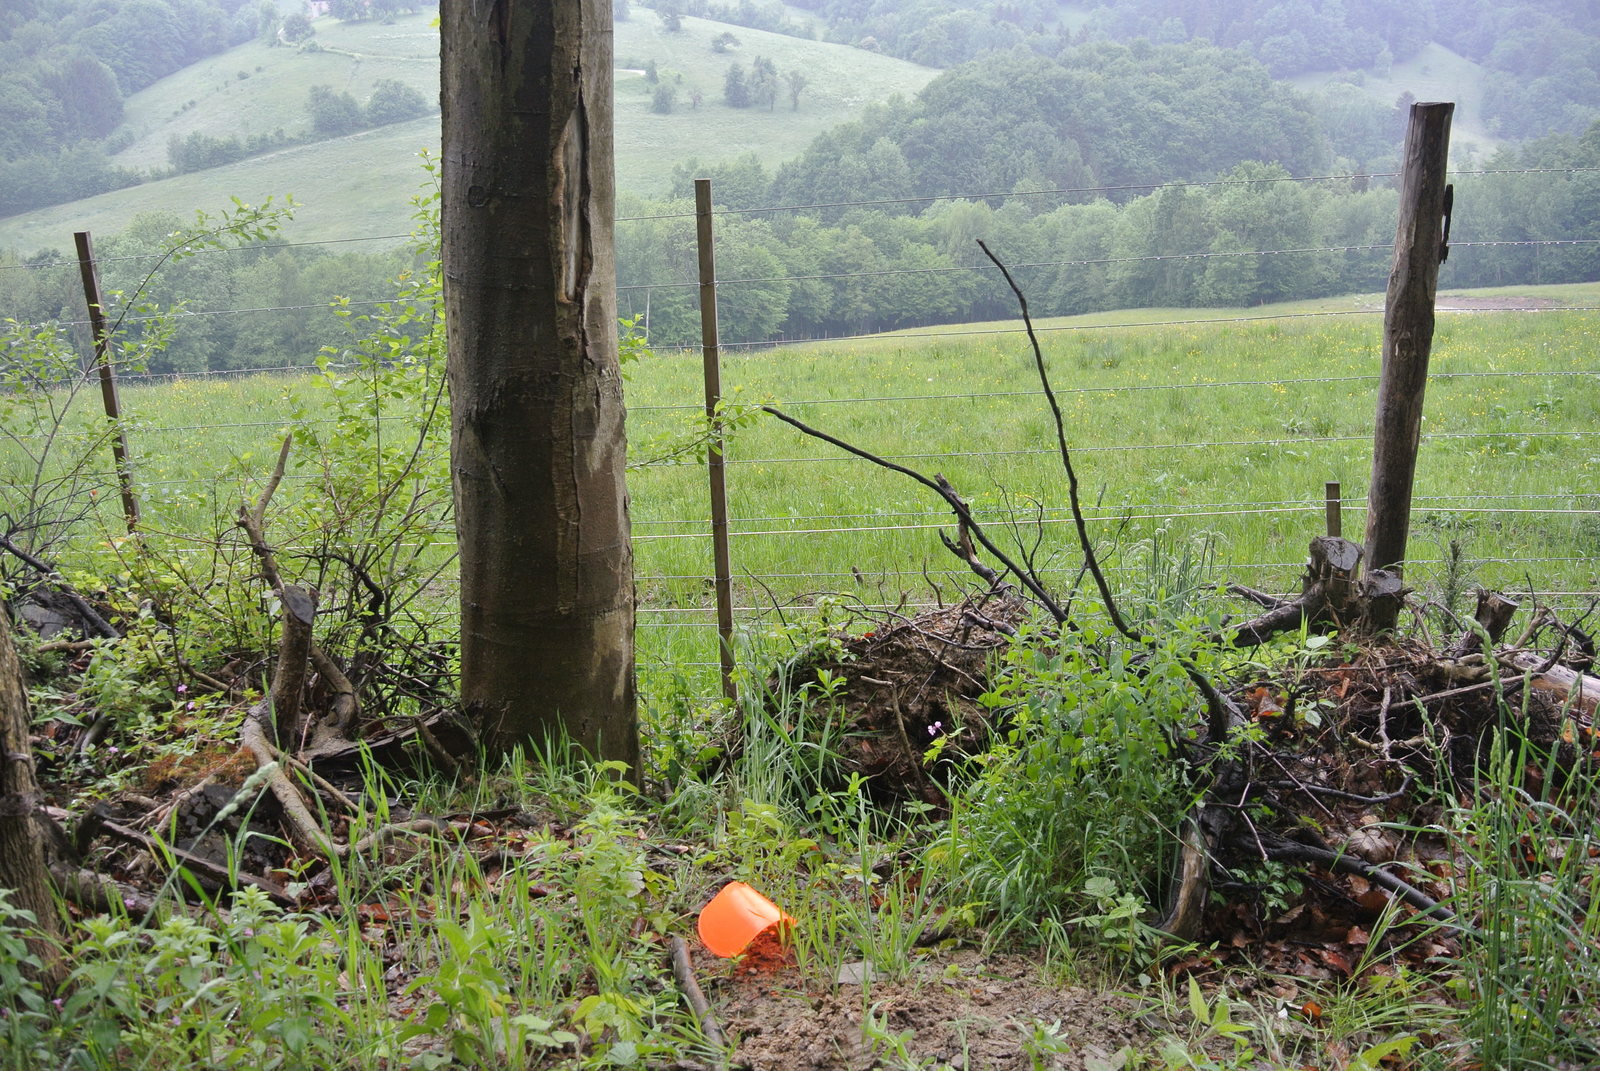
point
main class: Woodland
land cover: Broadleaved woodland
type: mesophytic deciduous forest
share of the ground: > 75 %
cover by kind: broadleaved forest trees 90 %, shrubs 10 %
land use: Forestry
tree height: > 5 m
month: May
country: AT
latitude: 48.0852
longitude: 15.8697
